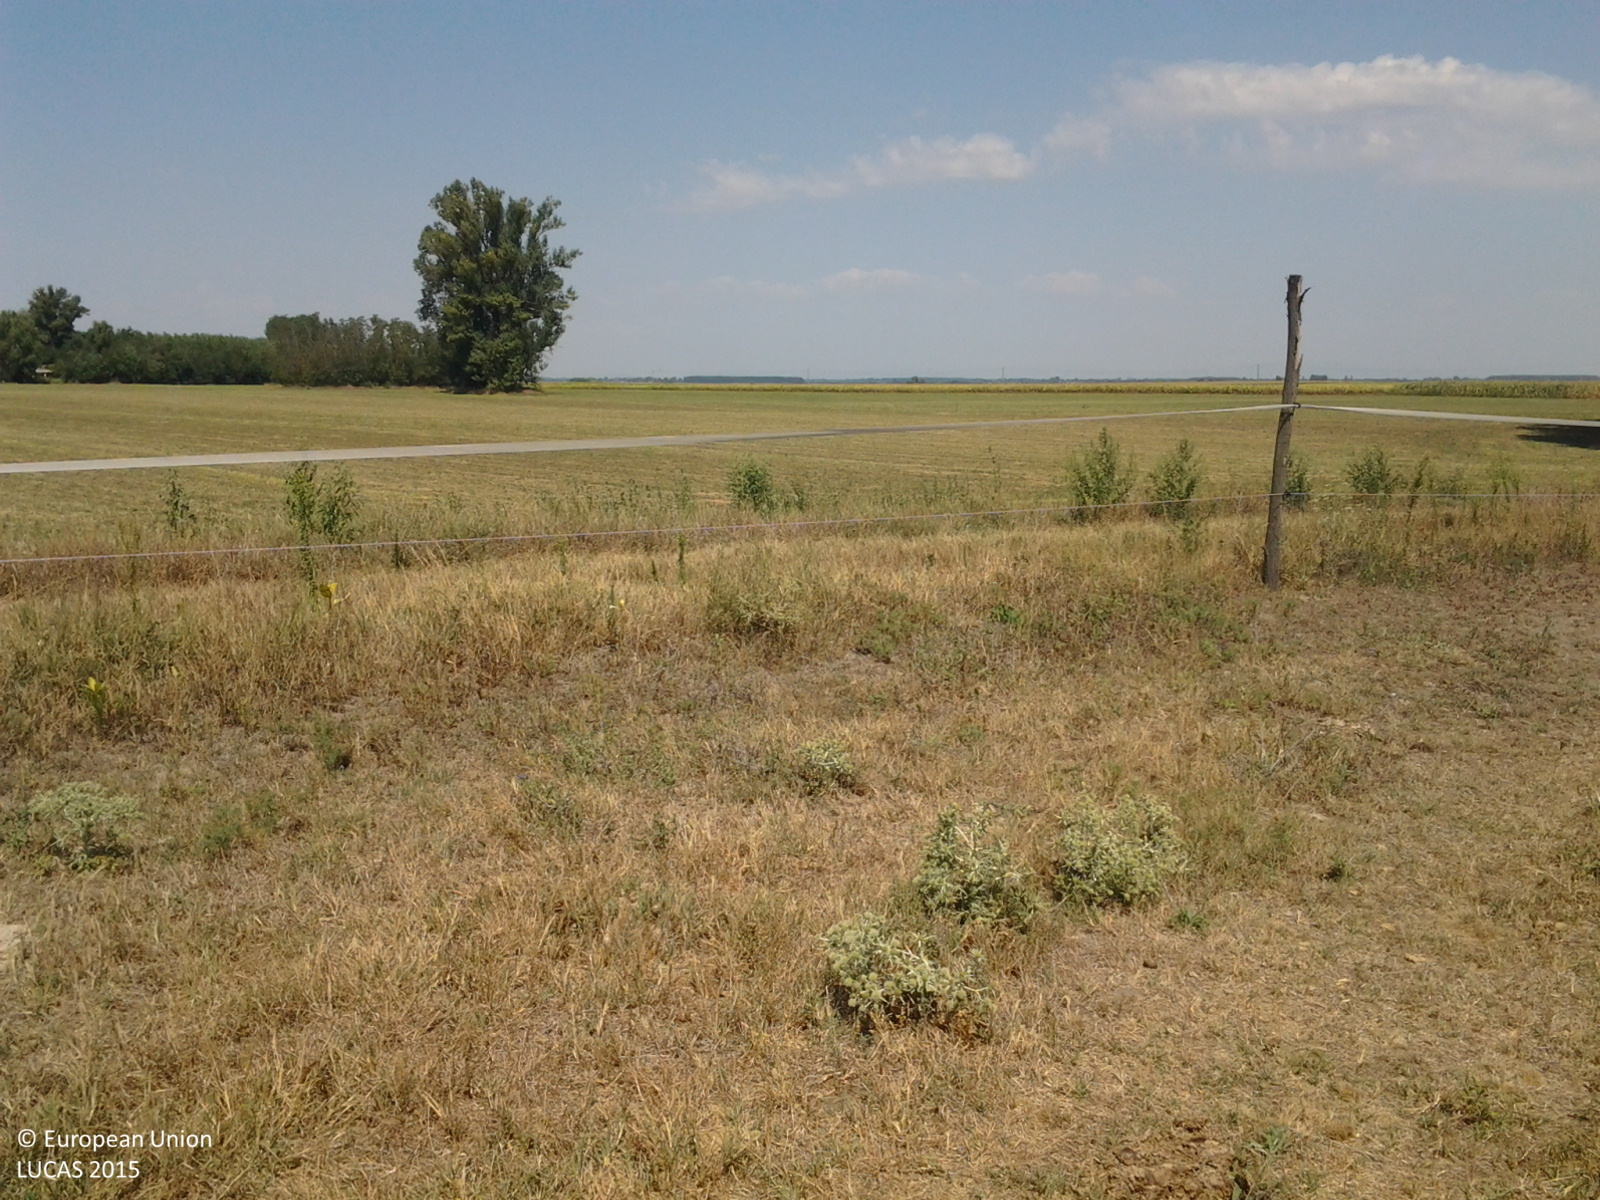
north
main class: Grassland
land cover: Grassland without tree/shrub cover
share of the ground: > 75 %
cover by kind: herbaceous plants 100 %
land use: Agriculture (excluding fallow land and kitchen gardens)
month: August
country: HU
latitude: 47.3883
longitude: 19.7867
